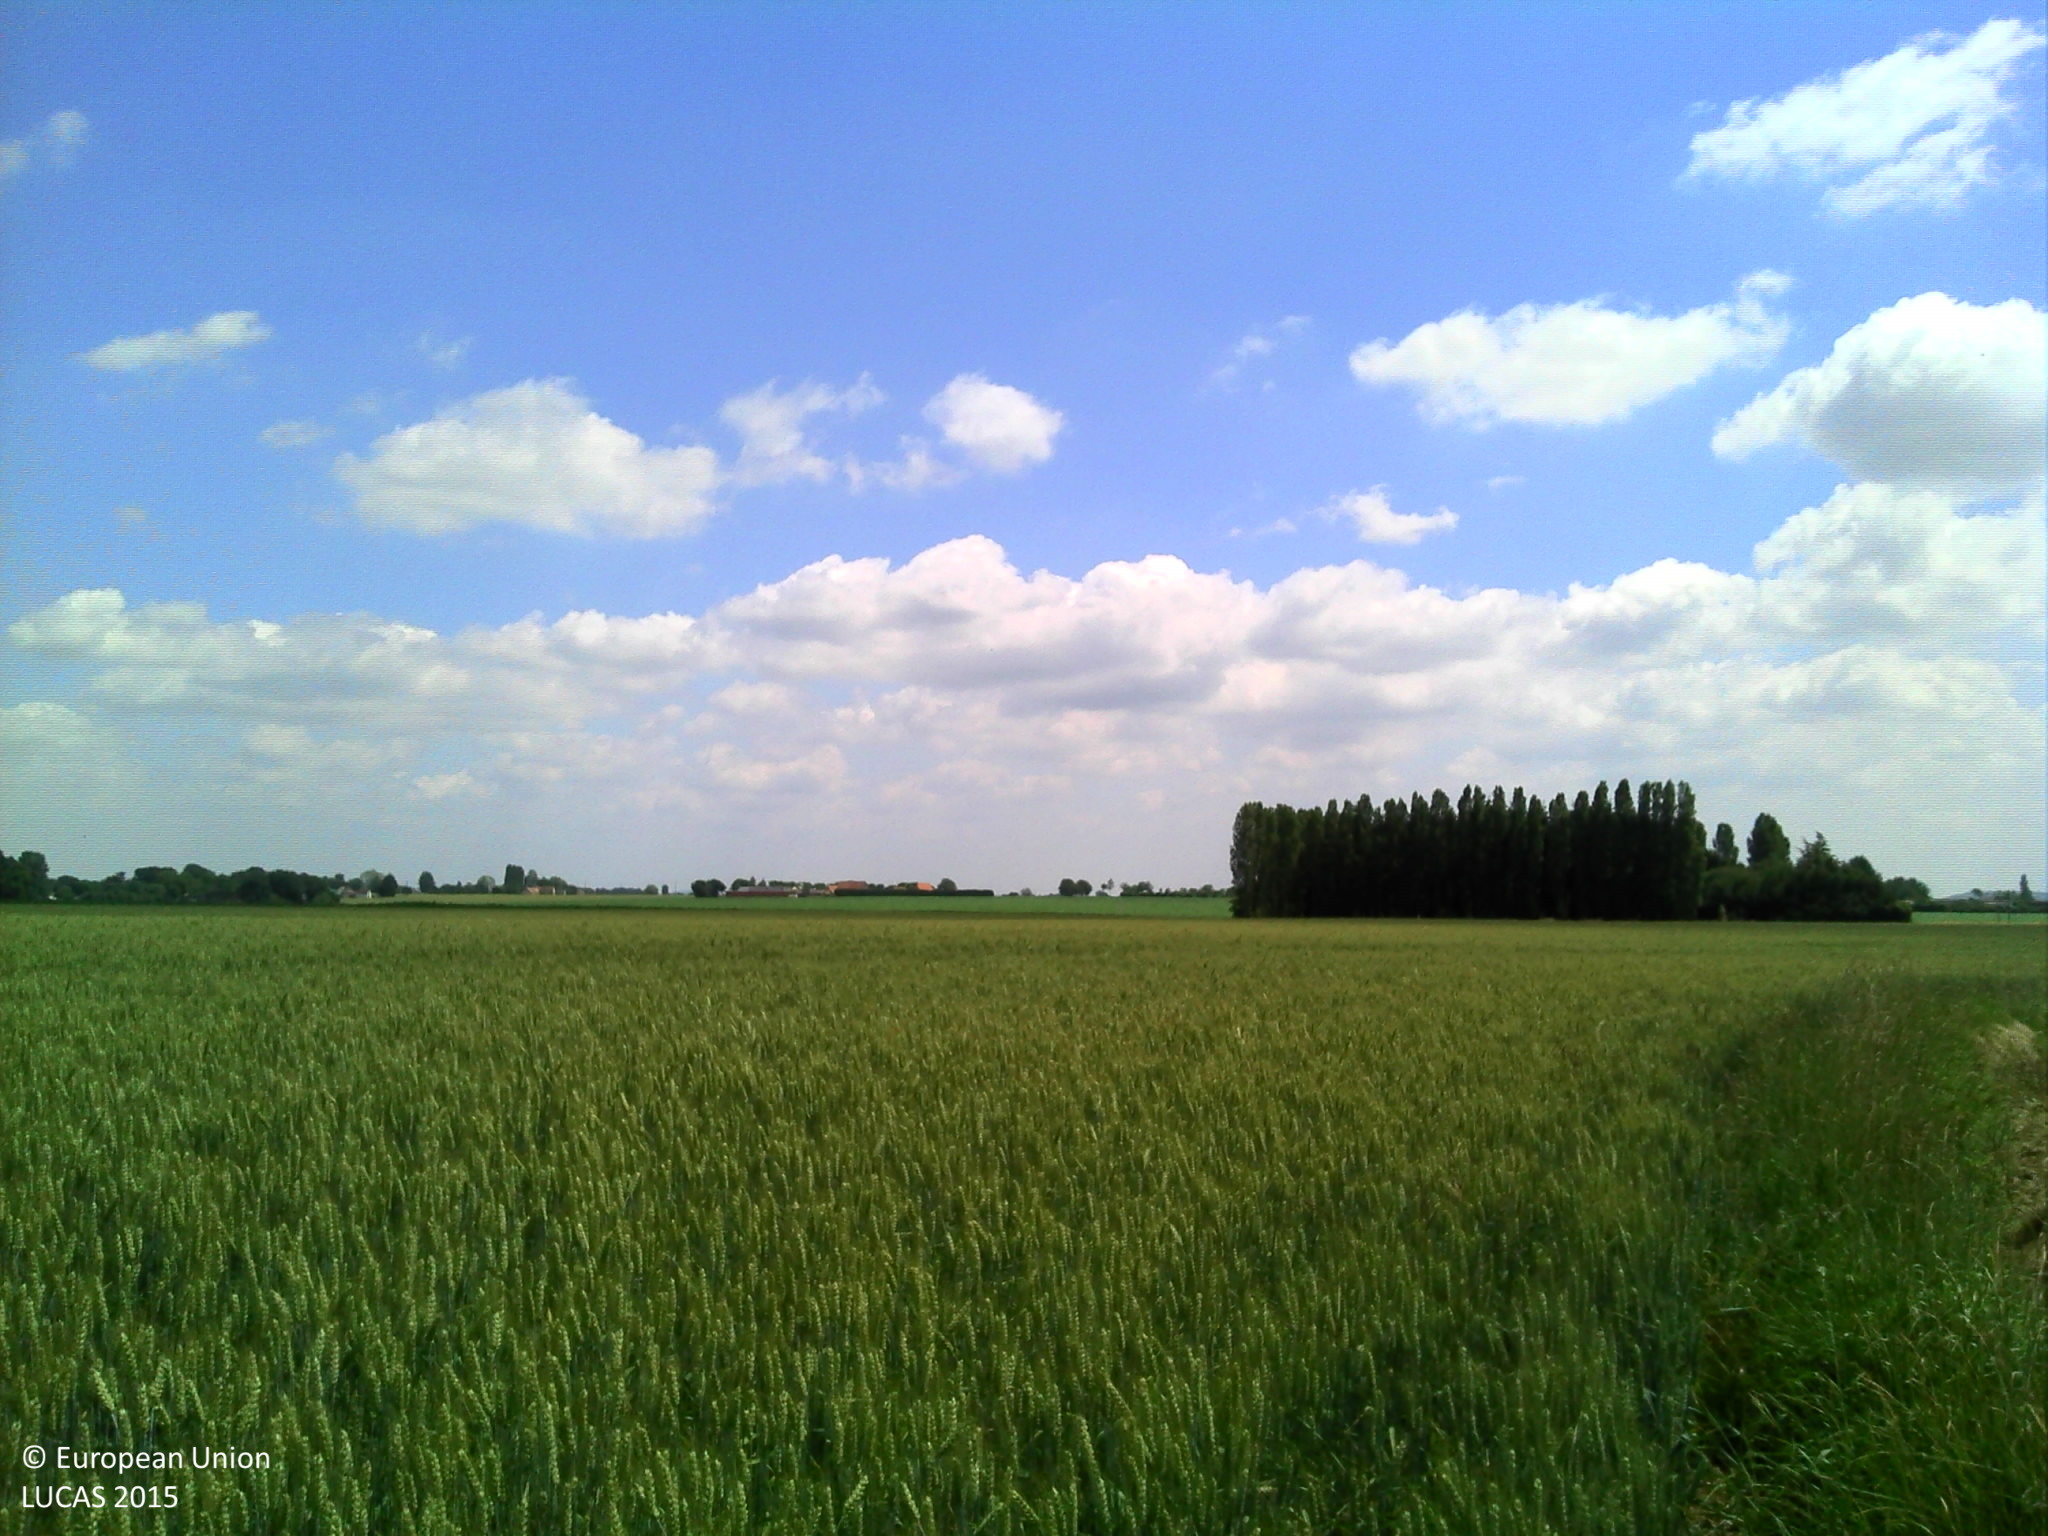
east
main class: Cropland
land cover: Common wheat
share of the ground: > 75 %
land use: Agriculture (excluding fallow land and kitchen gardens)
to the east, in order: Grass margins; Common wheat; Ditches and canals; Maize
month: June
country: FR
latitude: 48.2246
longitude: 0.2413
